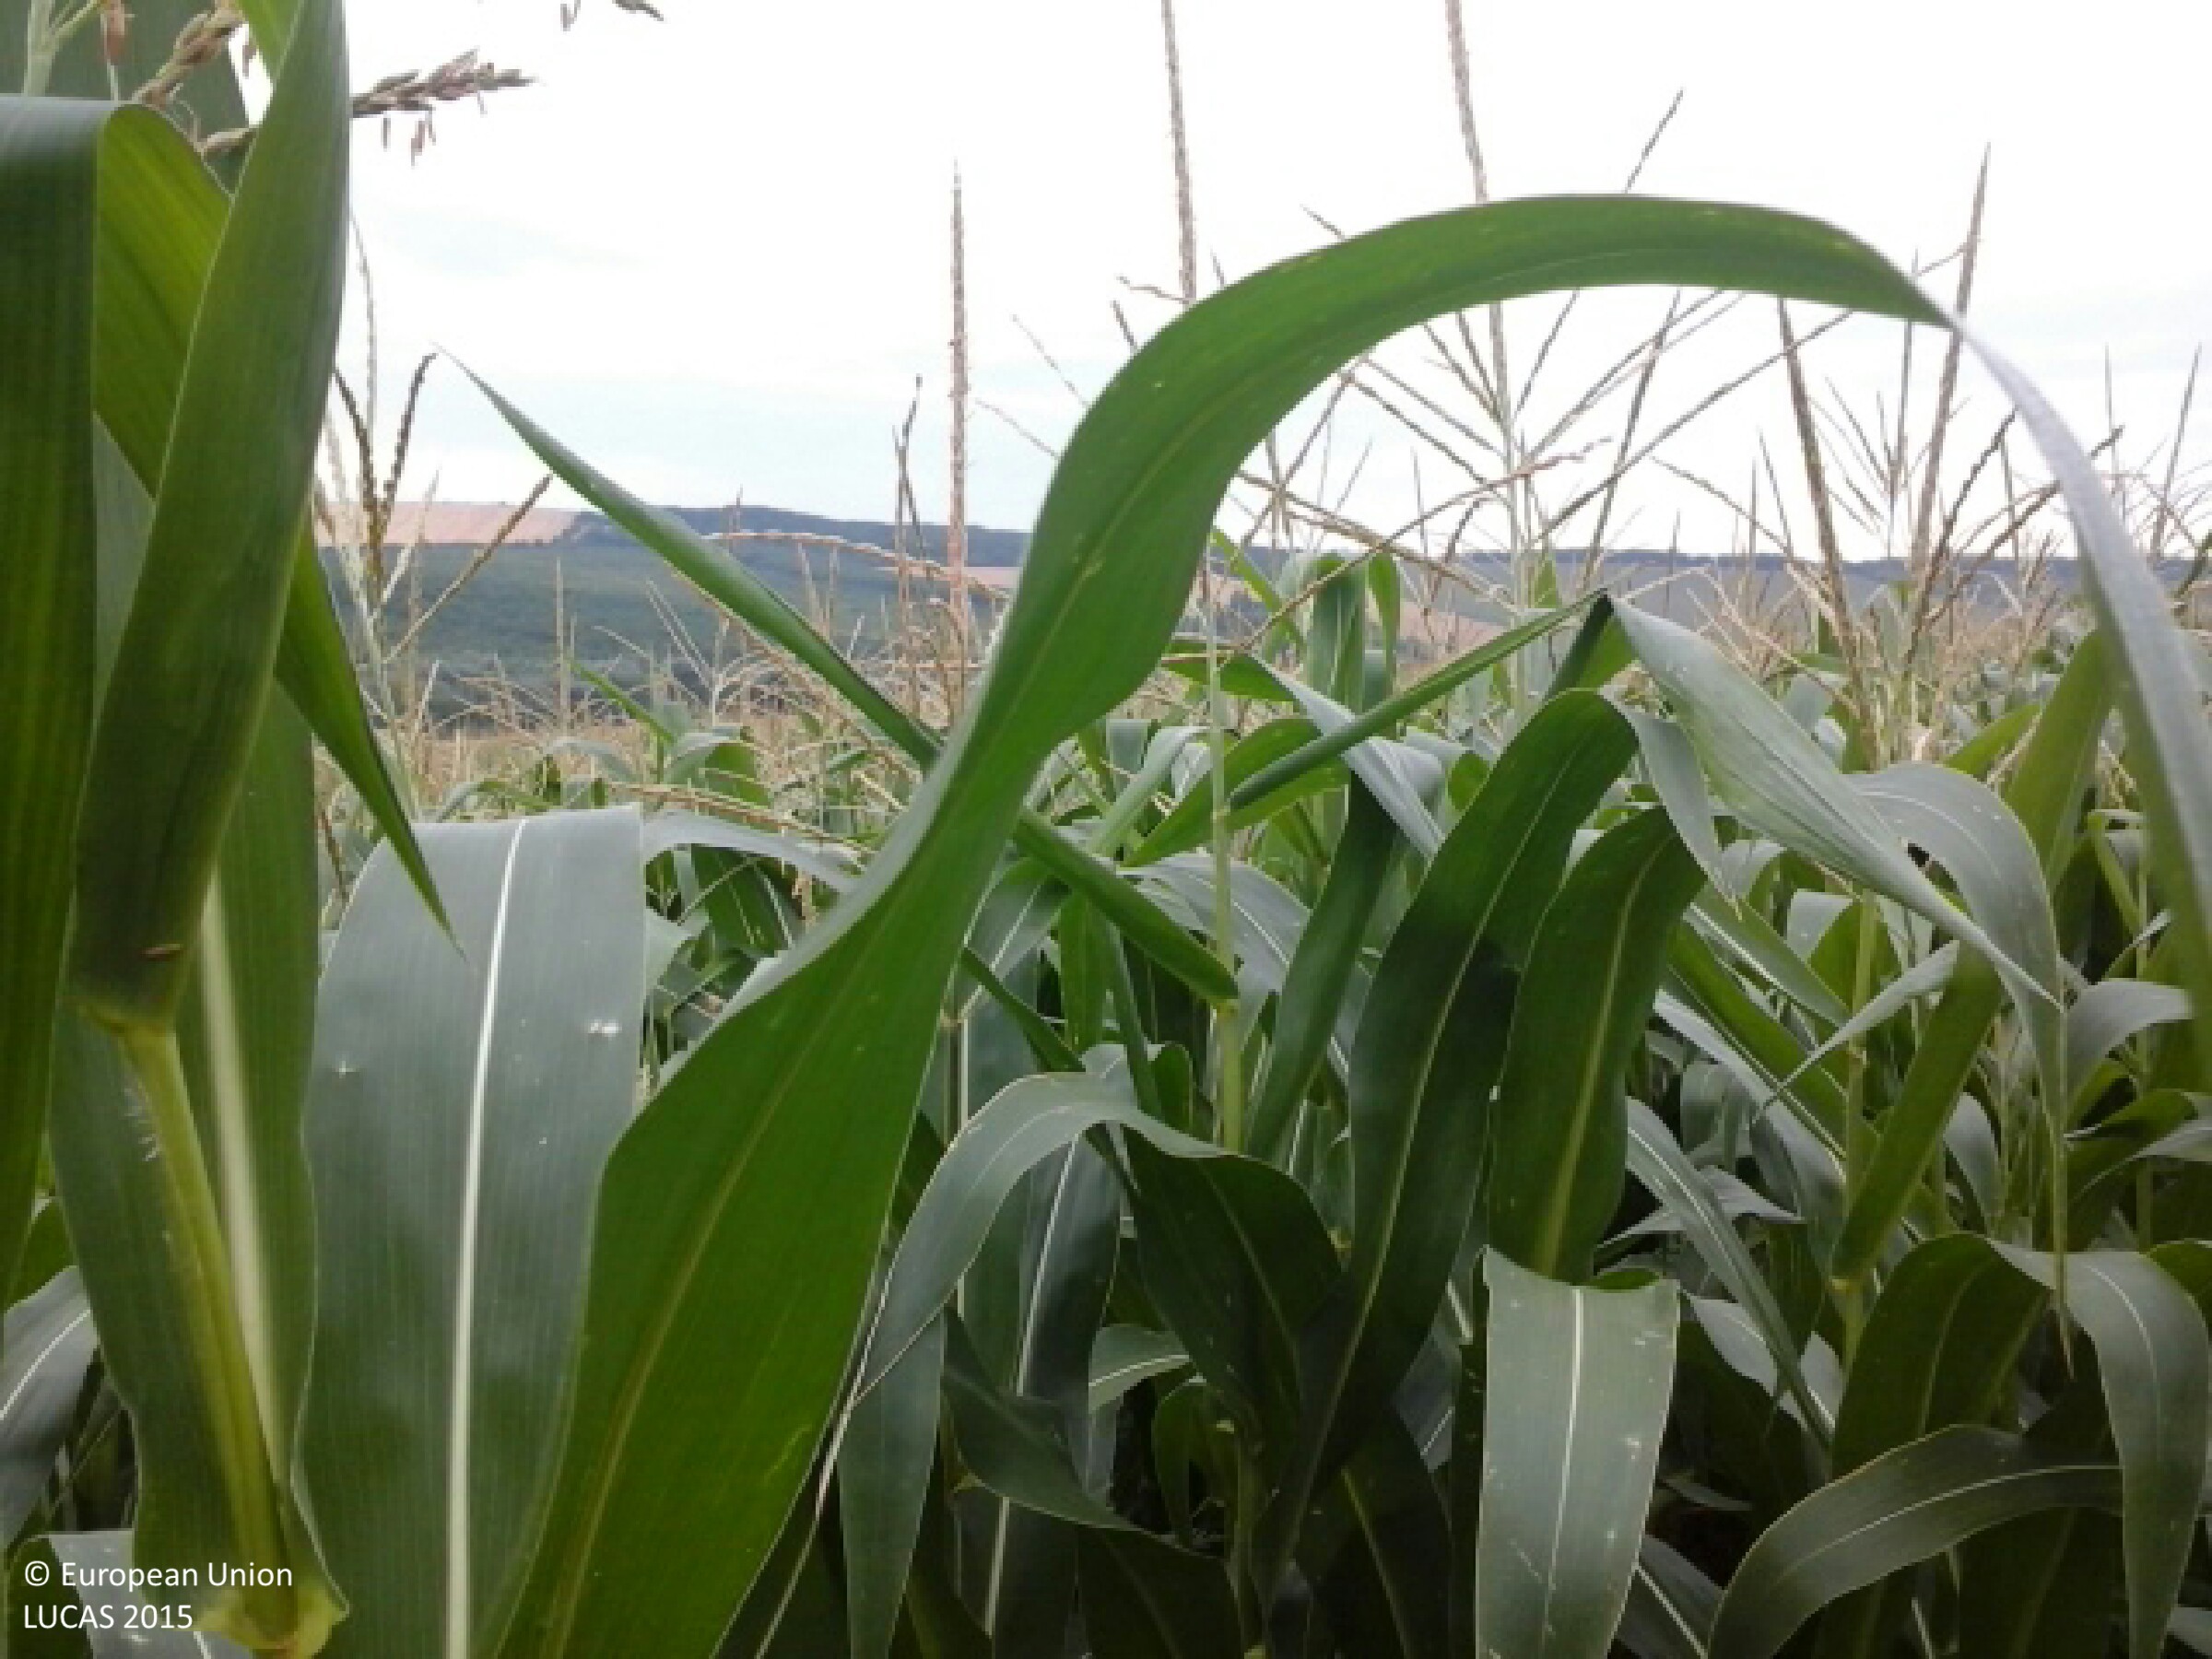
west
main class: Cropland
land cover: Maize
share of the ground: > 75 %
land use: Agriculture (excluding fallow land and kitchen gardens)
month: July
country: HU
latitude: 48.3600
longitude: 21.0131
